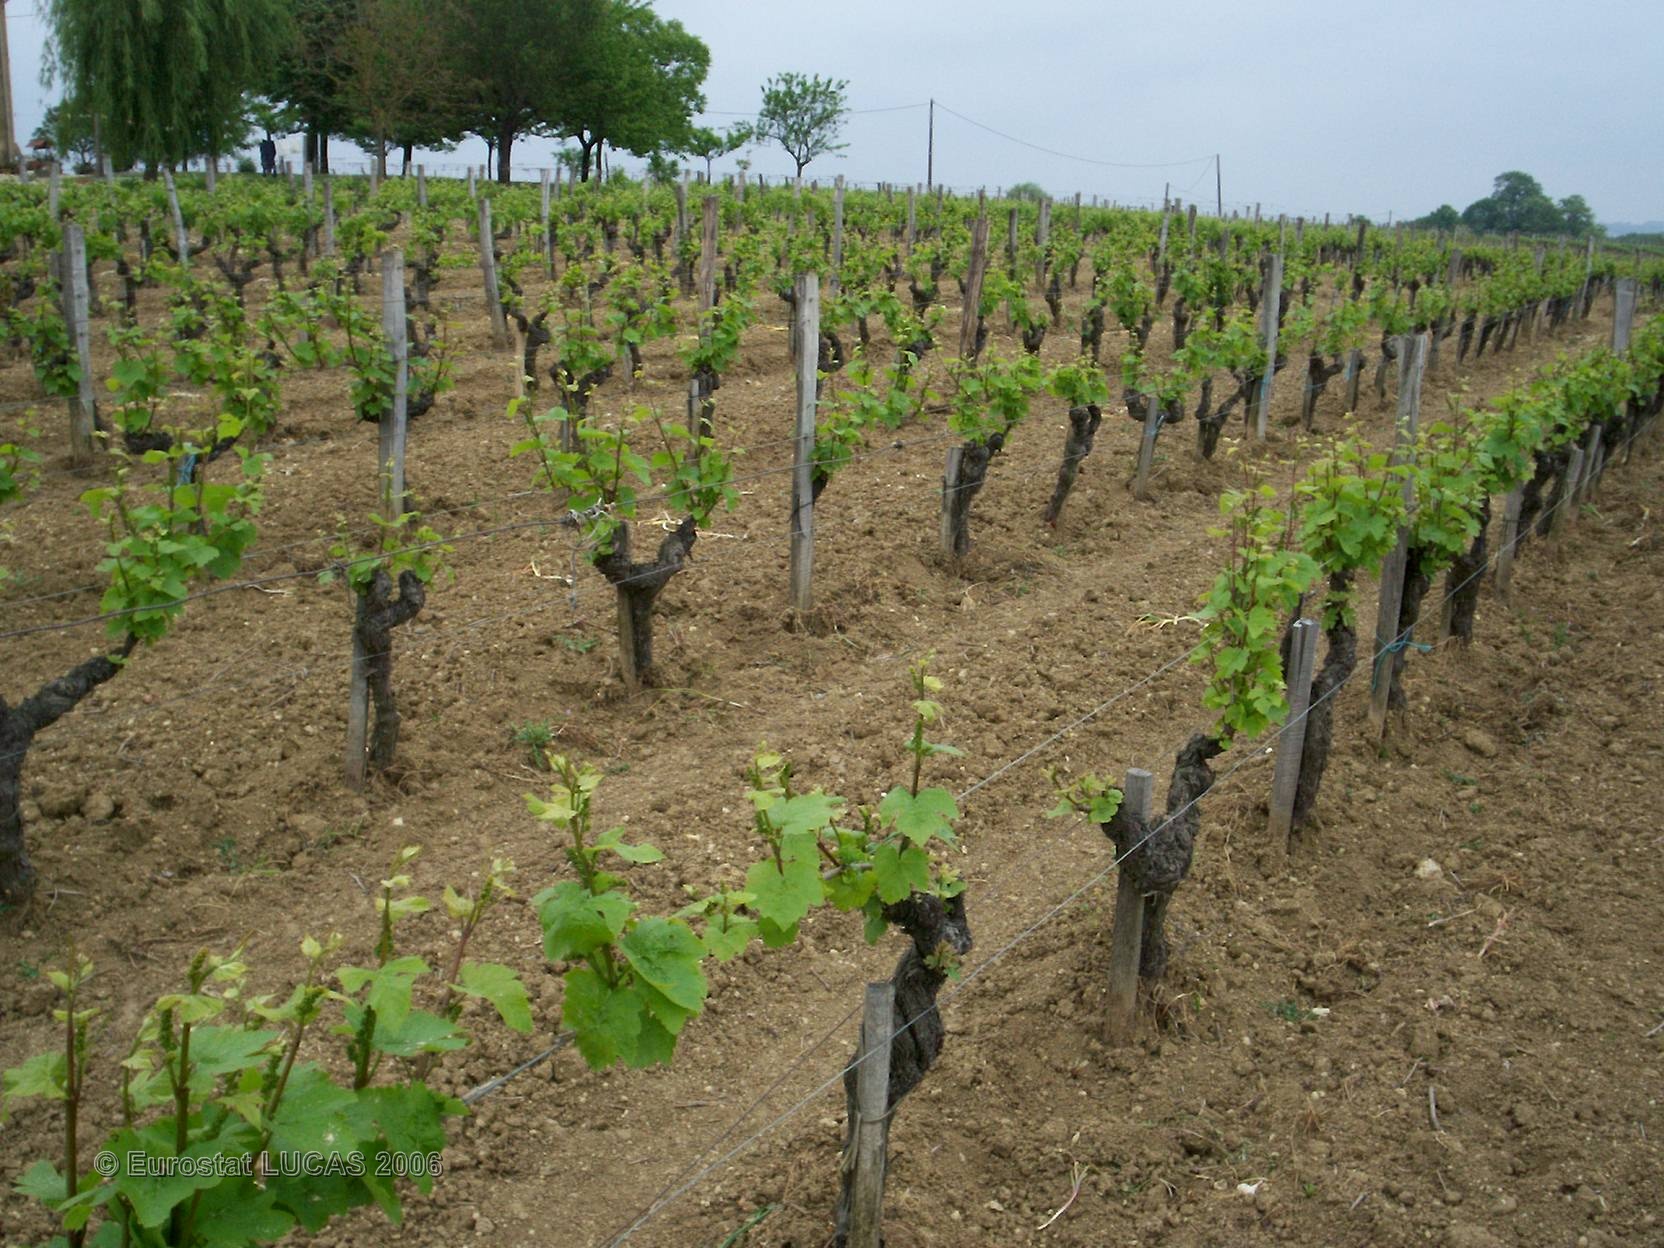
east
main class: Cropland
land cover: Vineyards
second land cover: Bare land
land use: Agriculture (excluding fallow land and kitchen gardens)
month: May
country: FR
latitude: 43.8901
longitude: 0.2472
